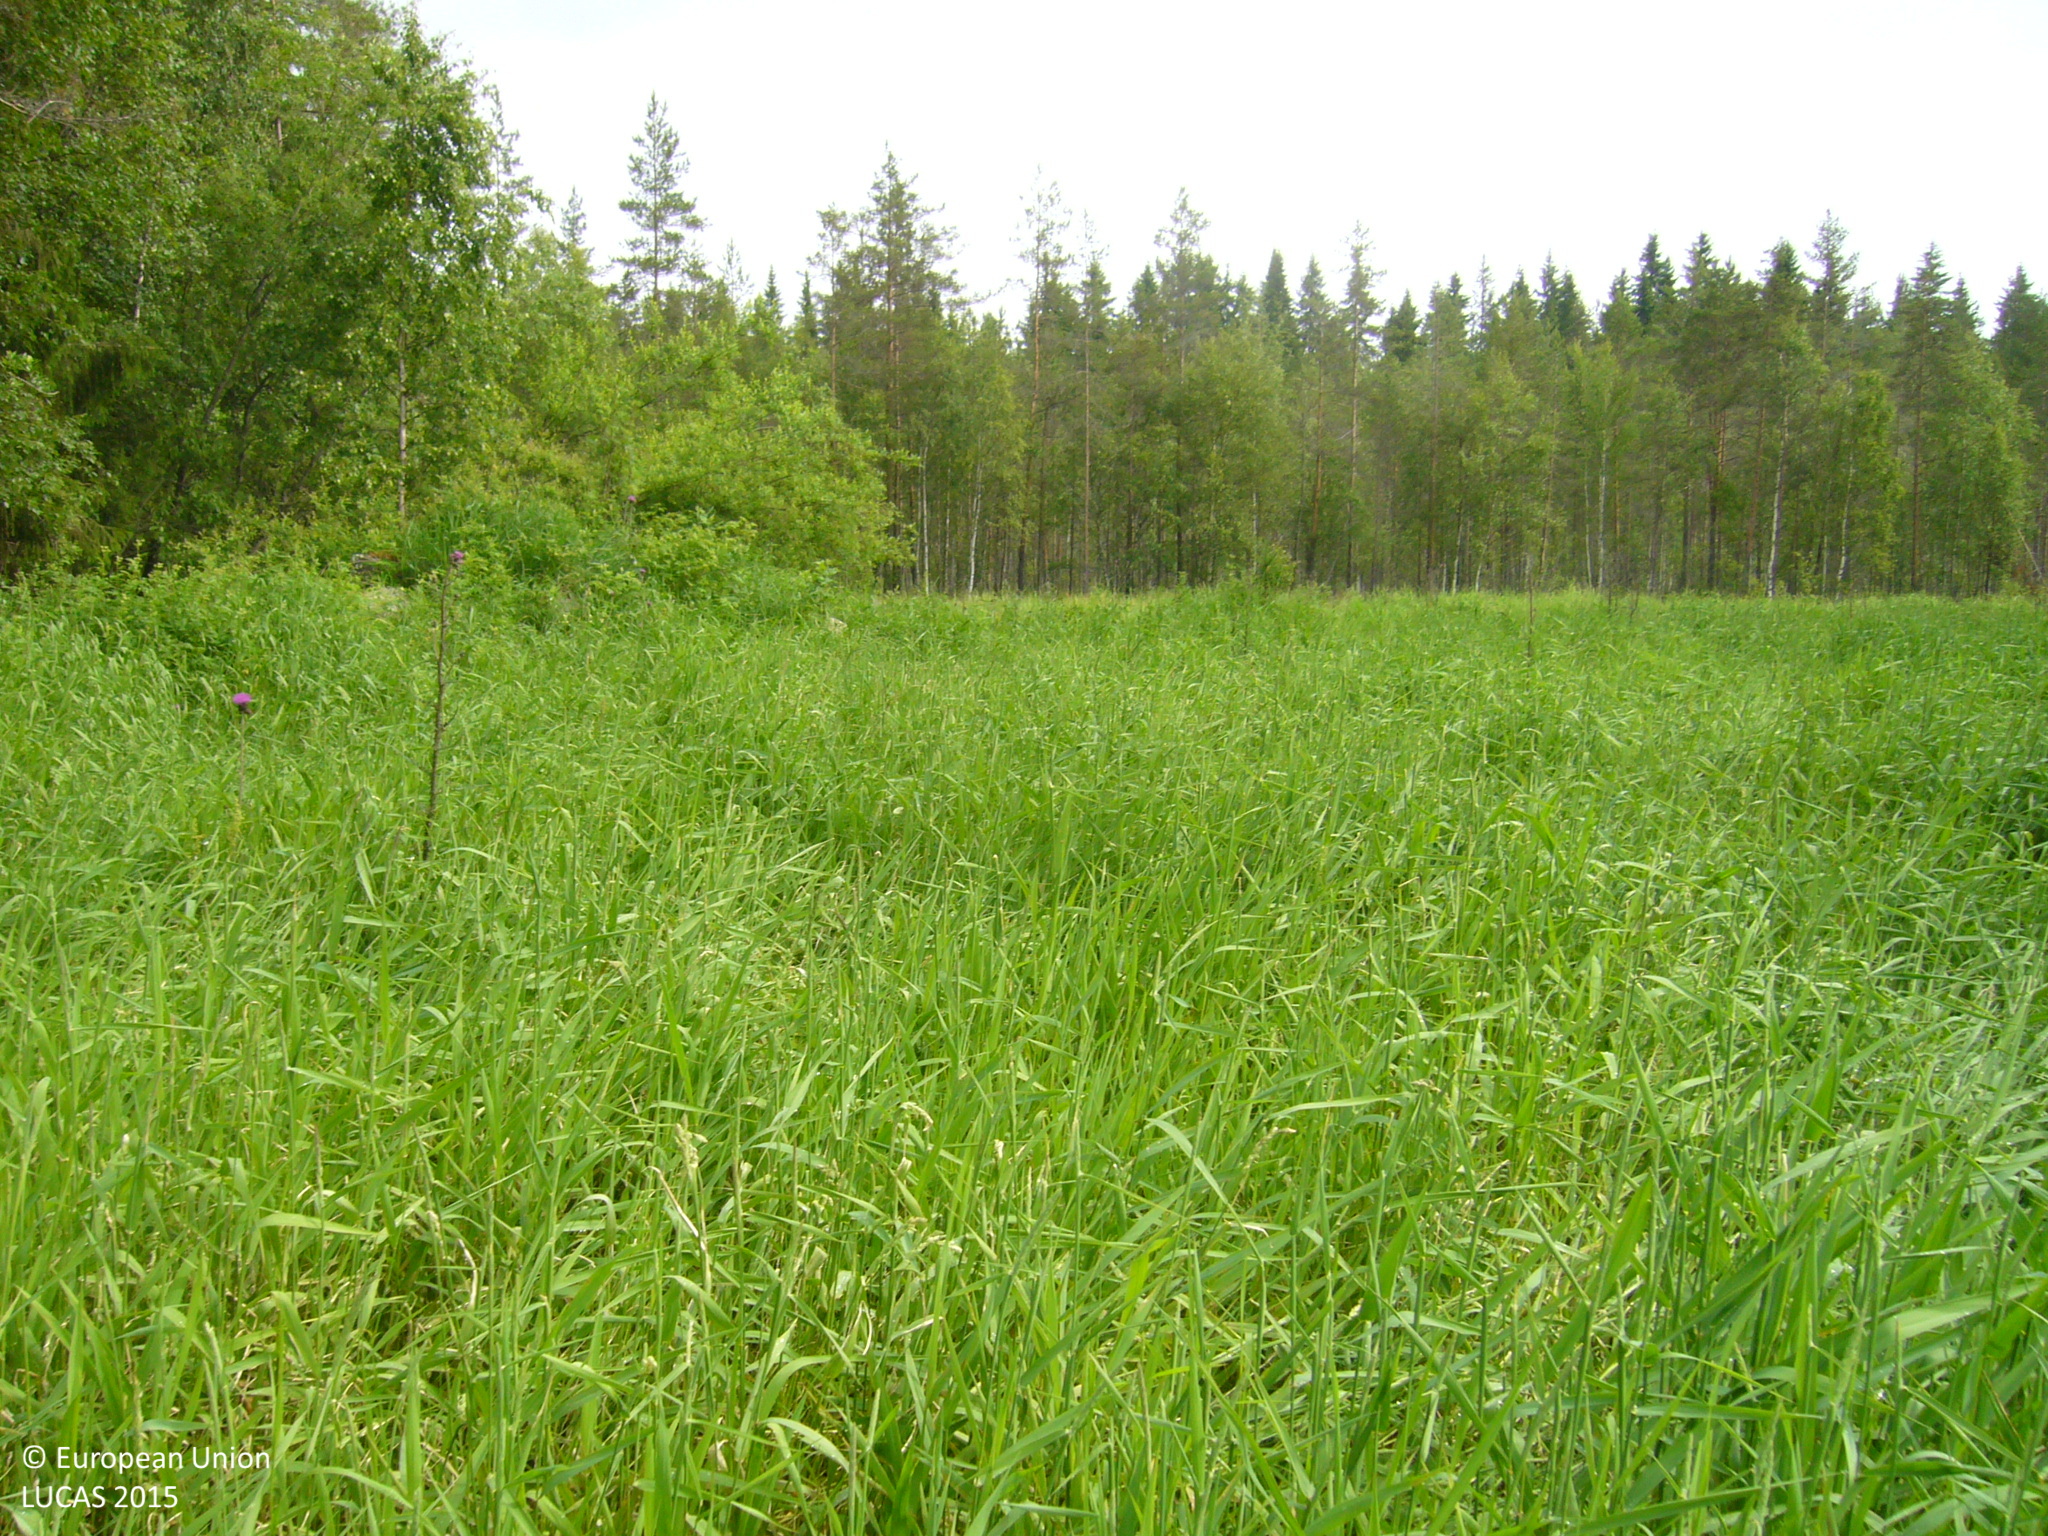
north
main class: Cropland
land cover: Temporary grasslands
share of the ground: > 75 %
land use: Agriculture (excluding fallow land and kitchen gardens)
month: July
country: FI
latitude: 63.5091
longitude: 25.5962
